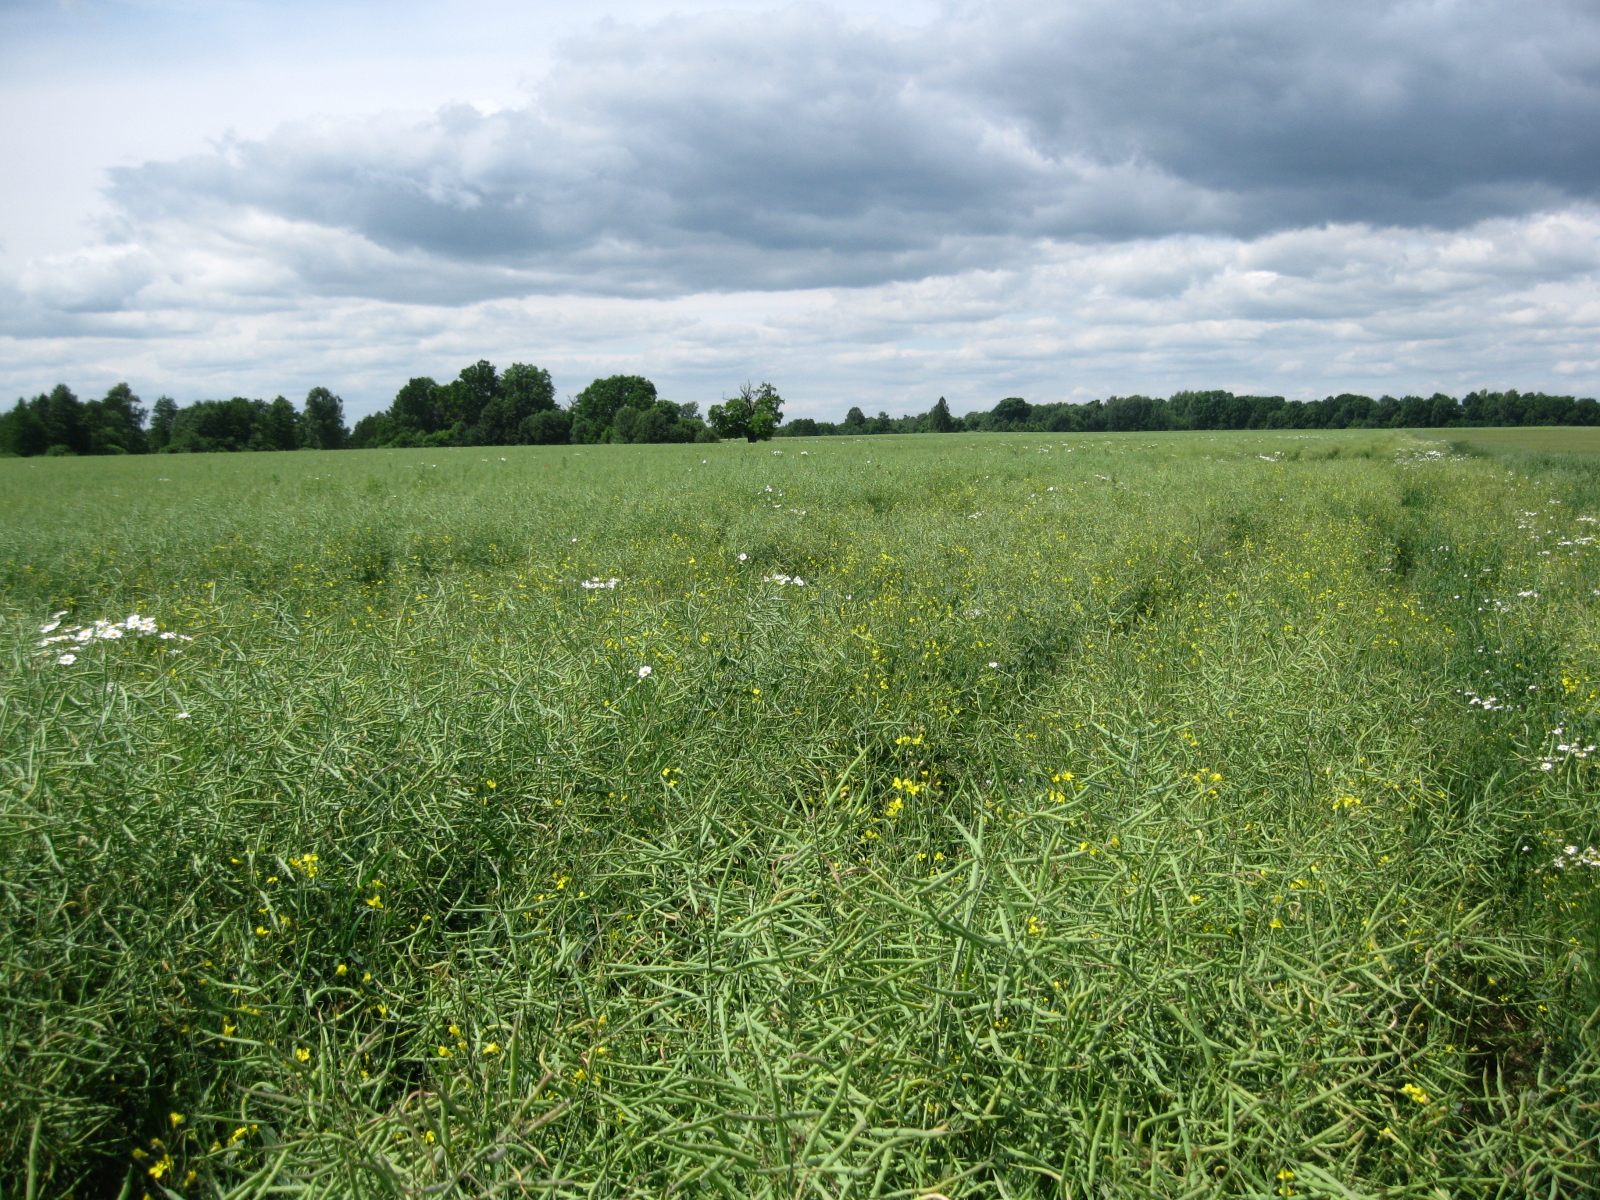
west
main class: Cropland
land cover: Rape and turnip rape
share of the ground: > 75 %
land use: Agriculture (excluding fallow land and kitchen gardens)
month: June
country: LT
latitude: 55.5760
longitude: 24.1937
